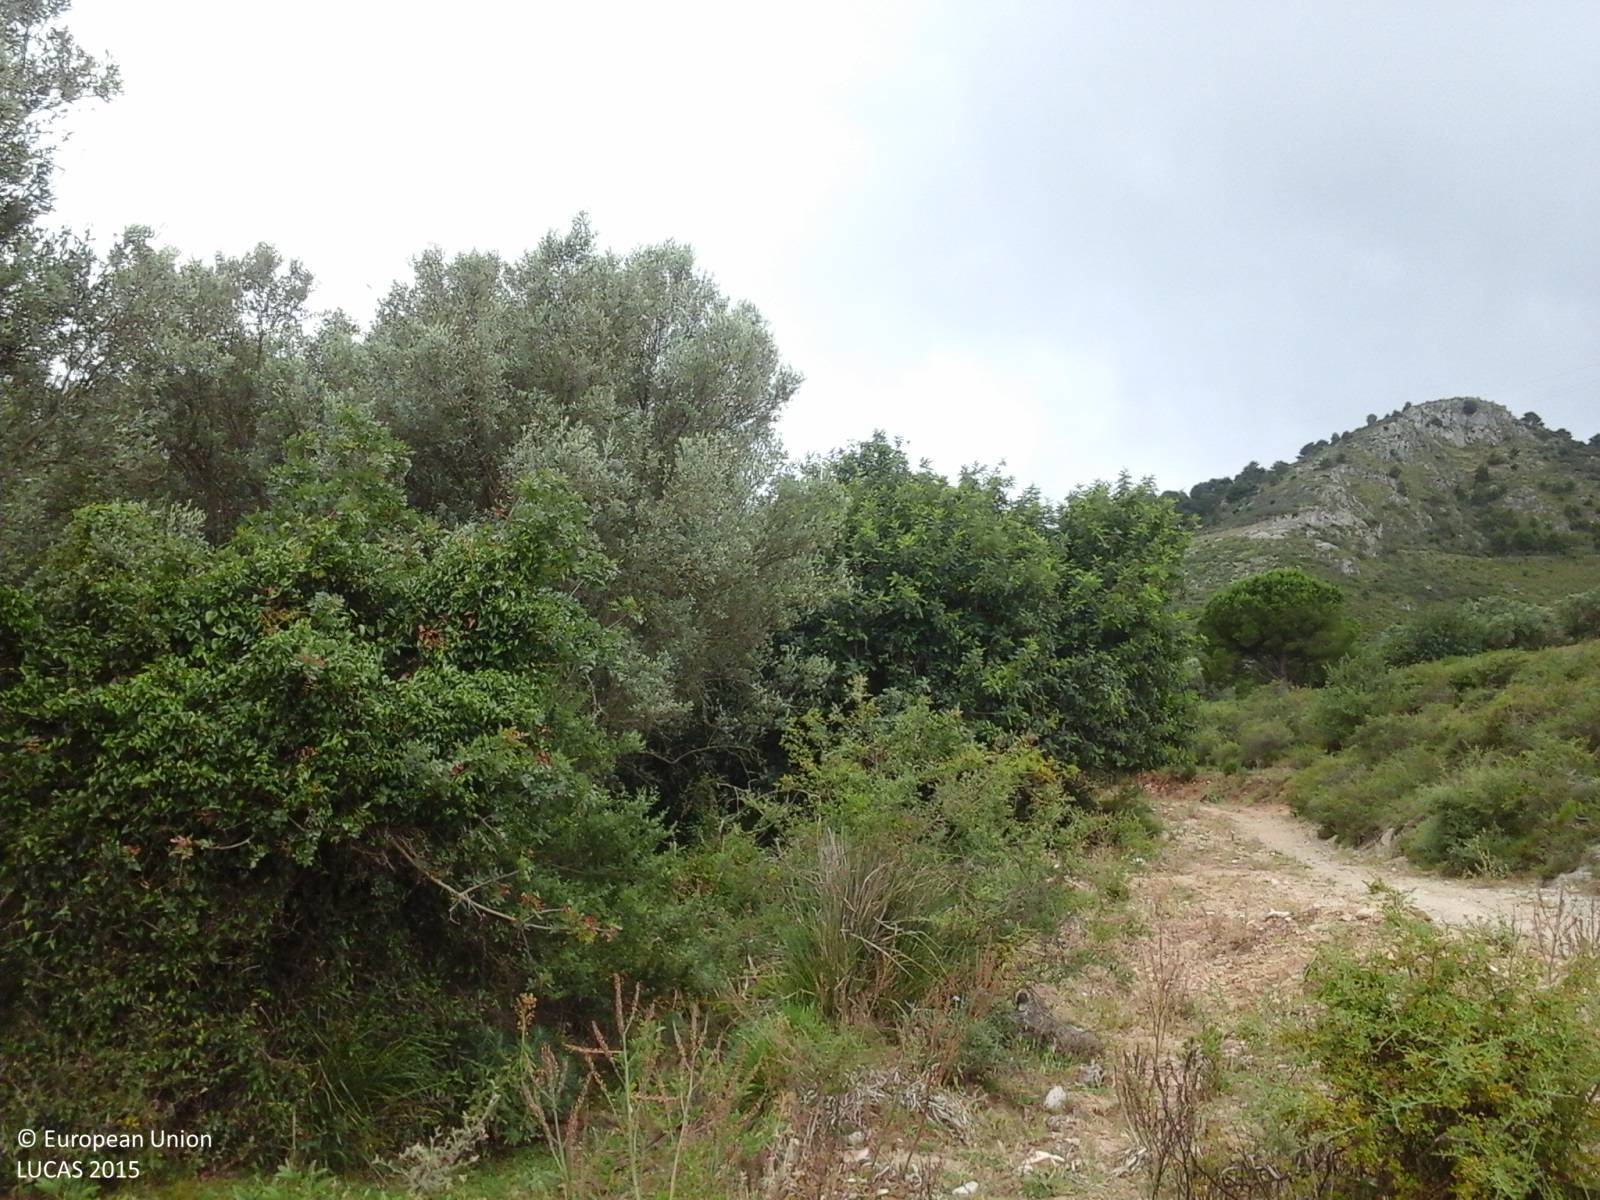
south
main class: Shrubland
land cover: Shrubland with sparse tree cover
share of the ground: > 75 %
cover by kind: herbaceous plants 75 %, shrubs 20 %, broadleaved forest trees 5 %
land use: Abandoned areas
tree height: < 5 m
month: June
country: IT
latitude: 38.1128
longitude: 13.1599
